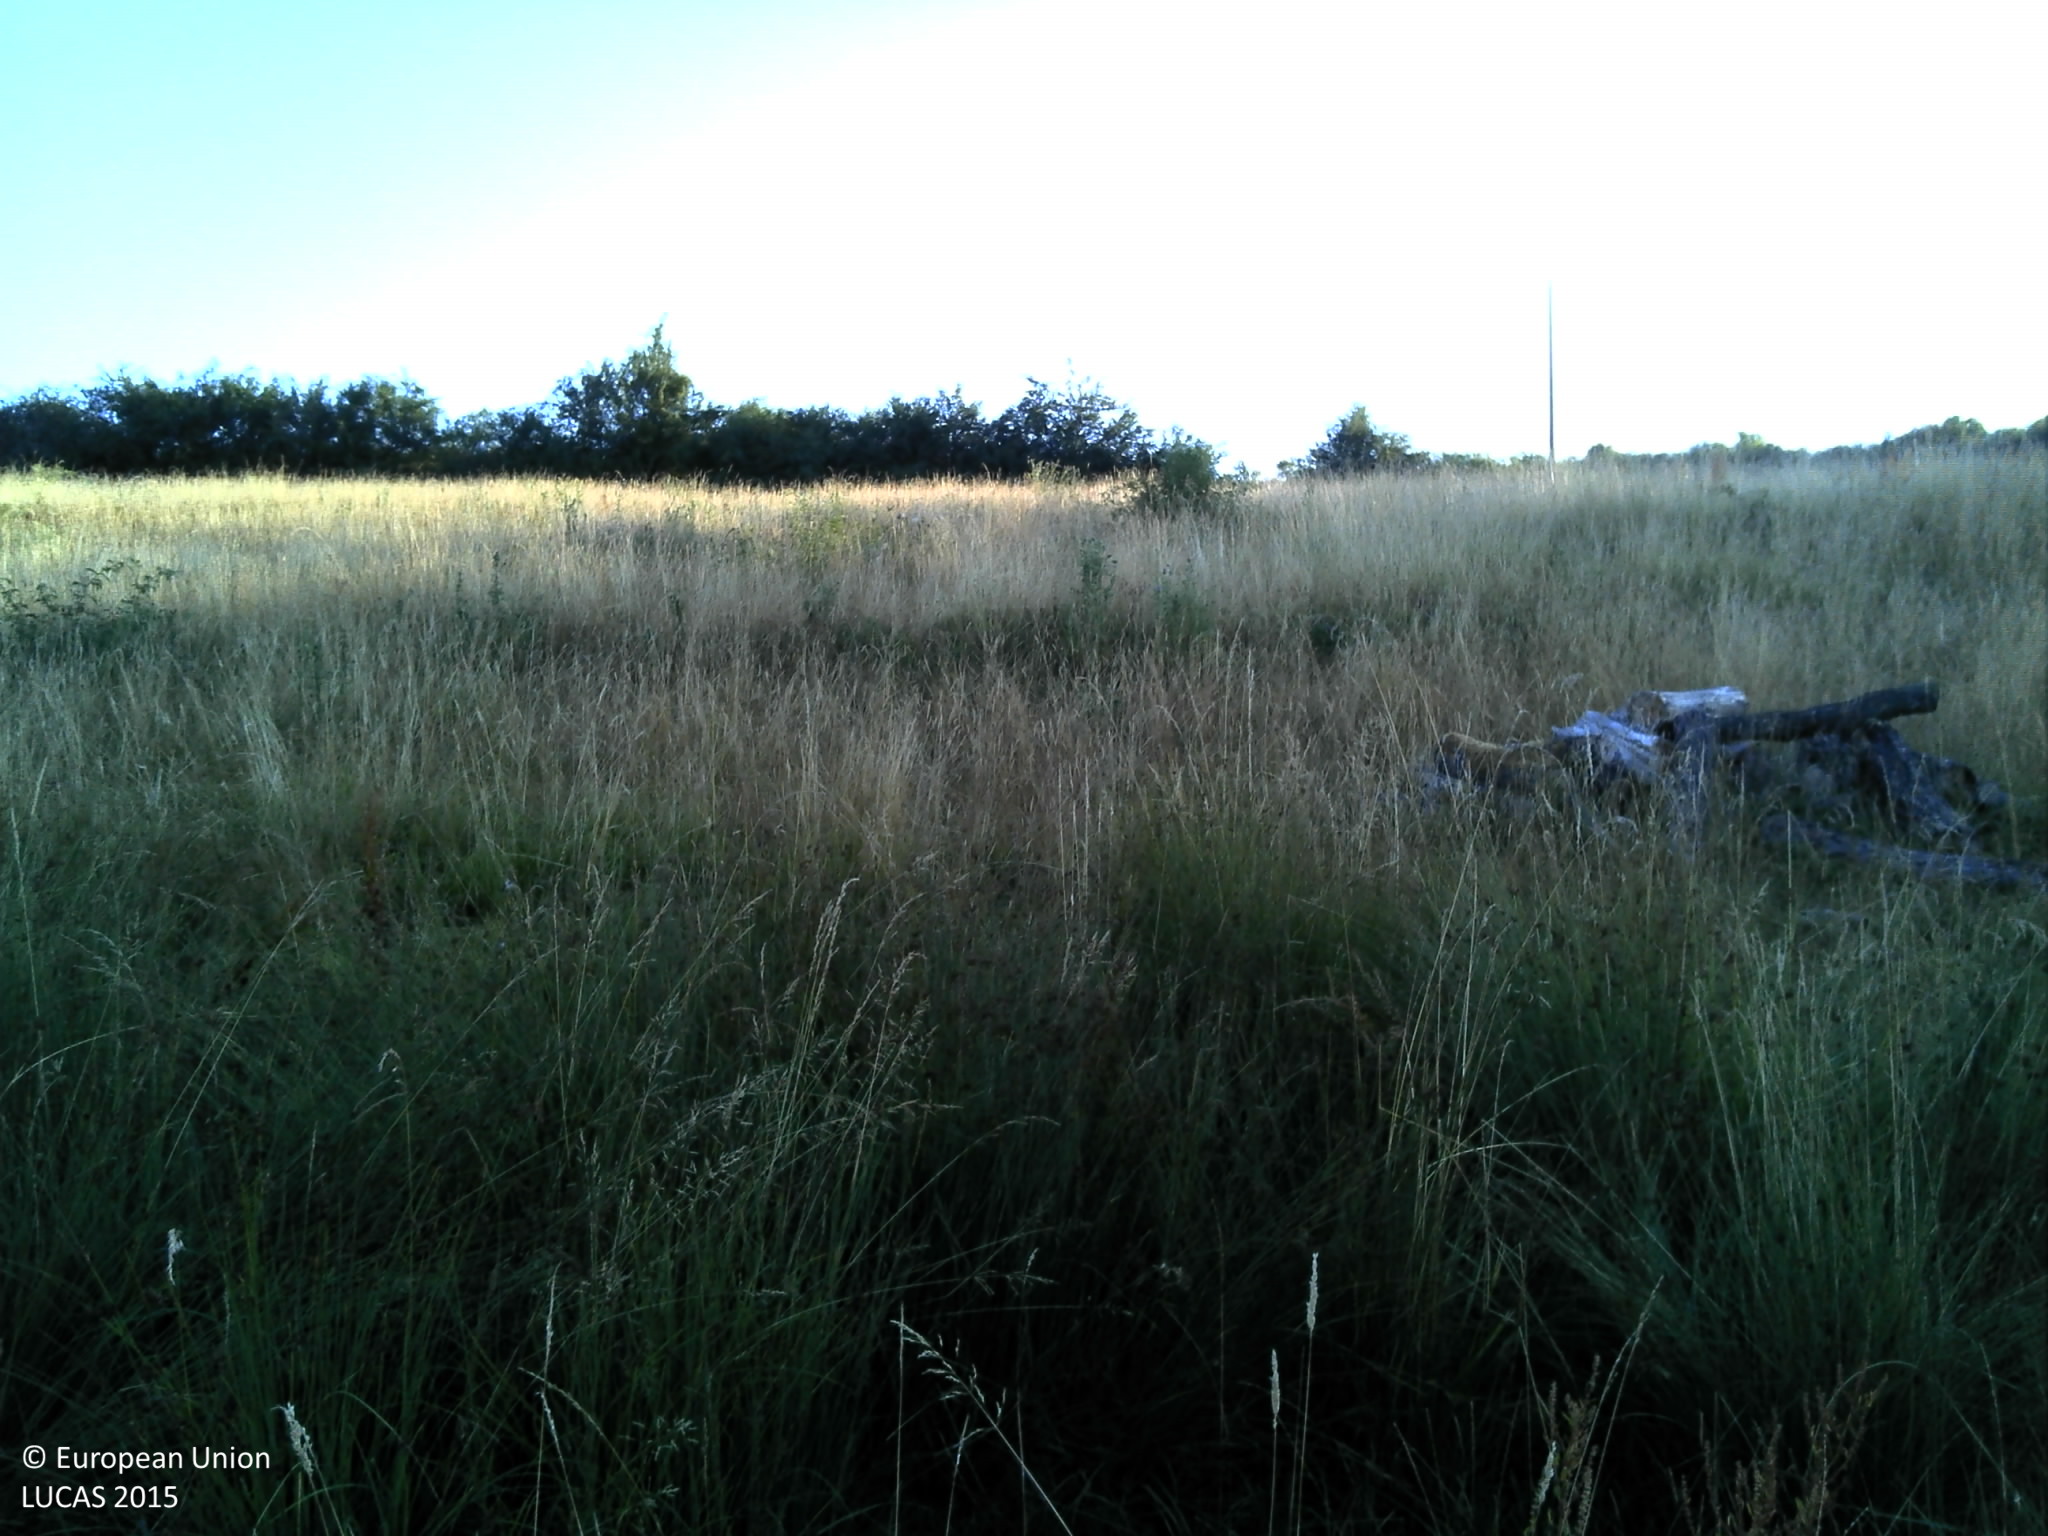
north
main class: Grassland
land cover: Grassland with sparse tree/shrub cover
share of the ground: > 75 %
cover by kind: herbaceous plants 95 %, broadleaved forest trees 5 %
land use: Forestry
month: July
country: FR
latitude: 48.3159
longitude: 6.0761
